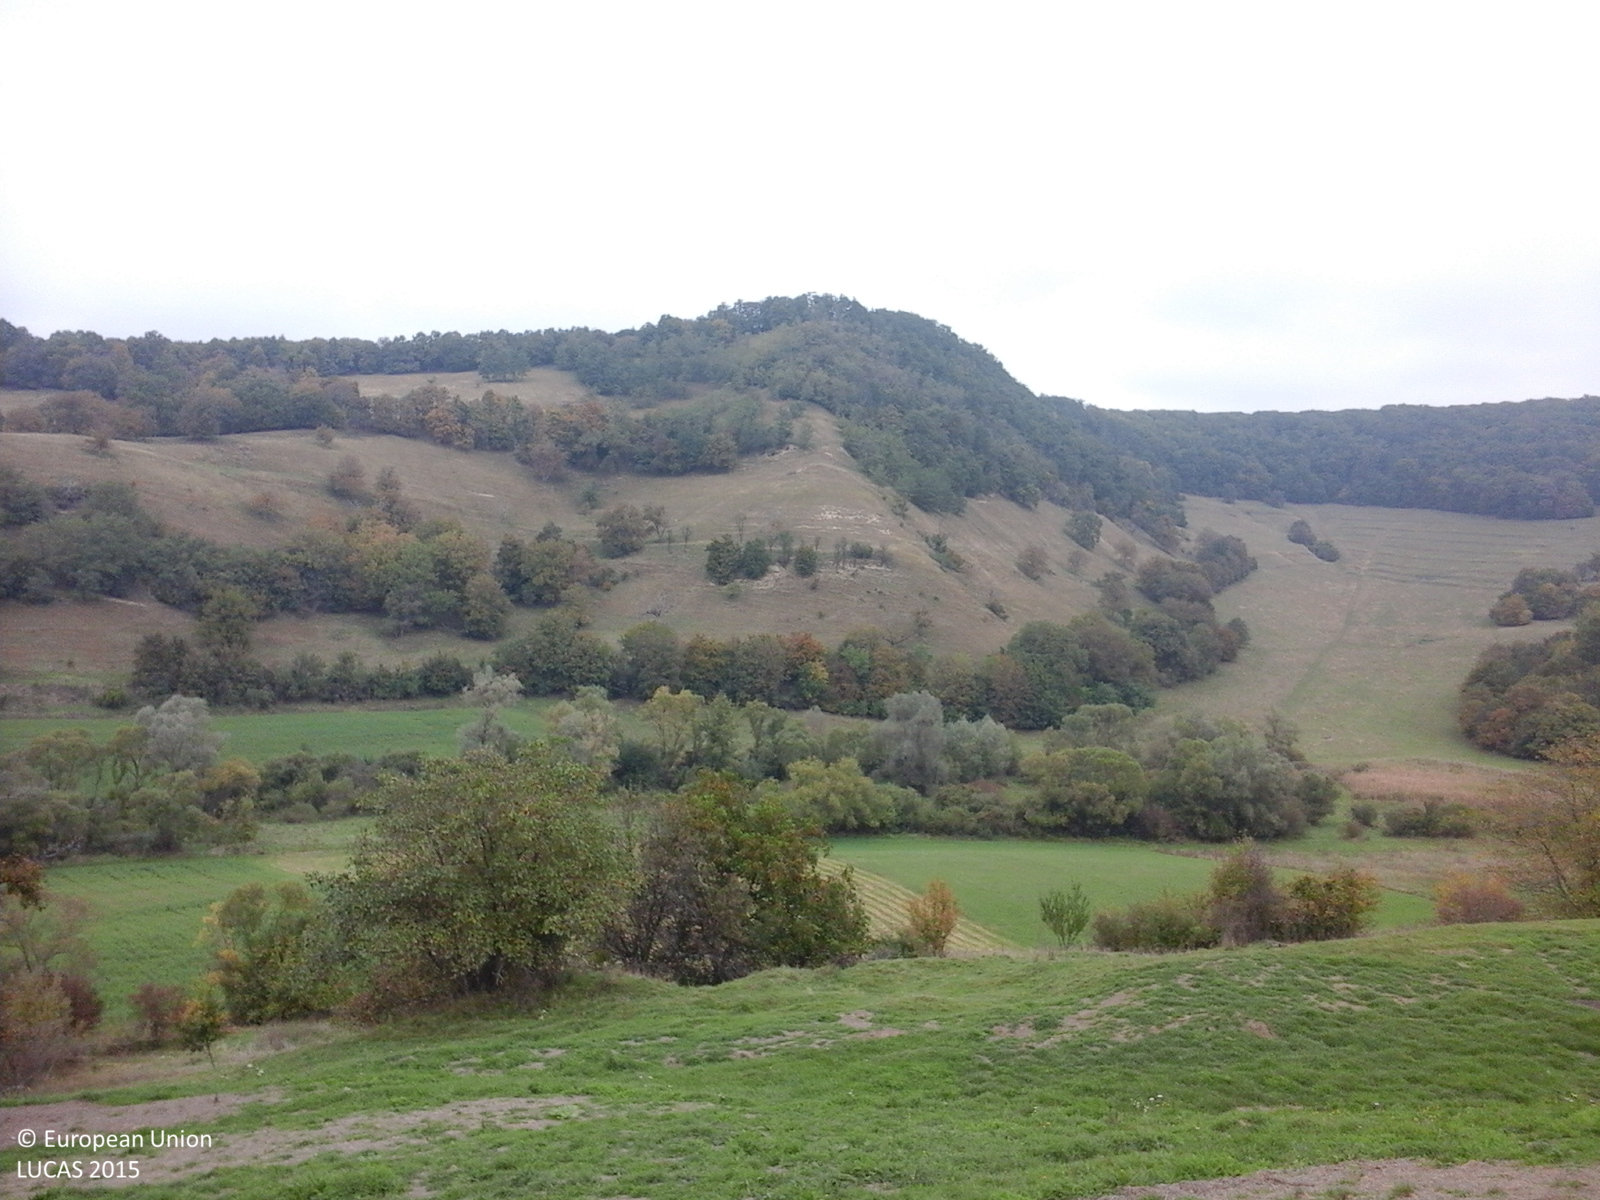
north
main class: Grassland
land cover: Grassland without tree/shrub cover
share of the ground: > 75 %
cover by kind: herbaceous plants 85 %, unconsolidated bare surface 15 %
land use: Agriculture (excluding fallow land and kitchen gardens)
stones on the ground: < 10 %
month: October
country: RO
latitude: 46.1476
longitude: 24.7320
